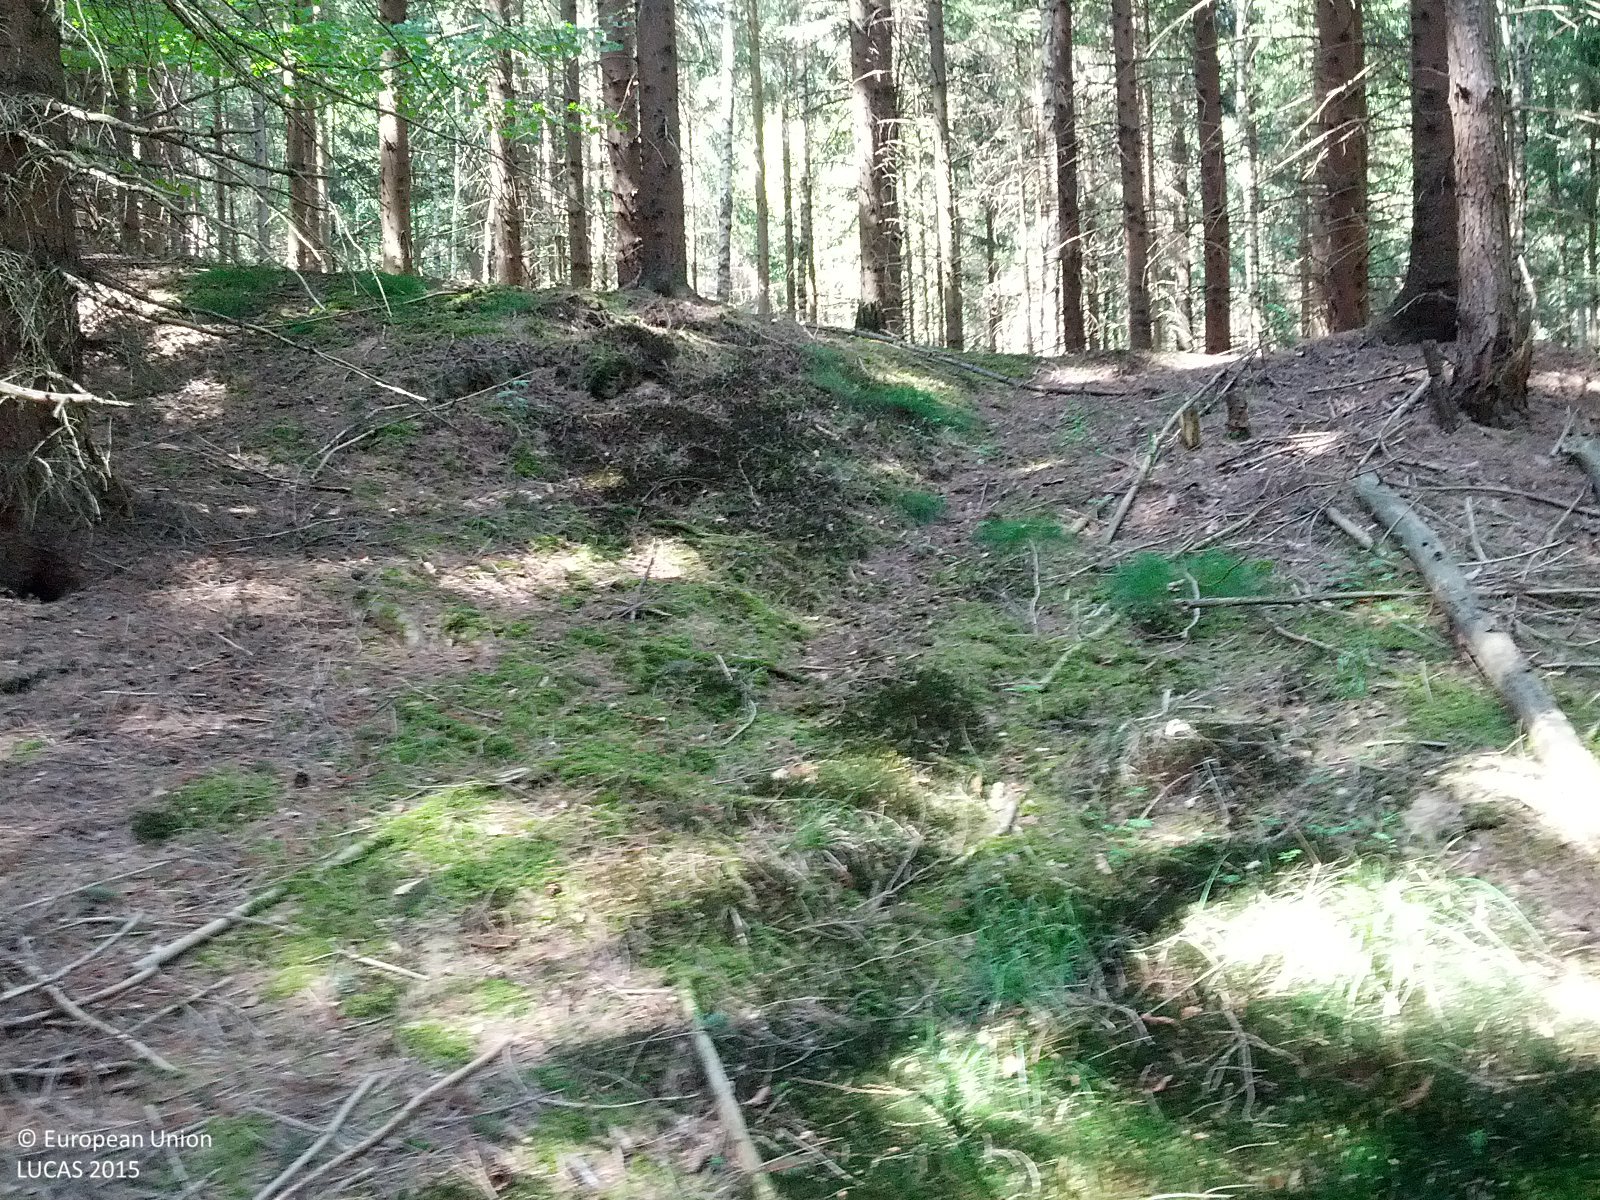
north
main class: Woodland
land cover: Spruce dominated coniferous woodland
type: boreal forest
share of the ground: > 75 %
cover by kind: coniferous forest trees 80 %, lichens and mosses 10 %, broadleaved forest trees 5 %, herbaceous plants 5 %
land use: Forestry
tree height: > 5 m
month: May
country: AT
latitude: 47.4057
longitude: 16.0847
